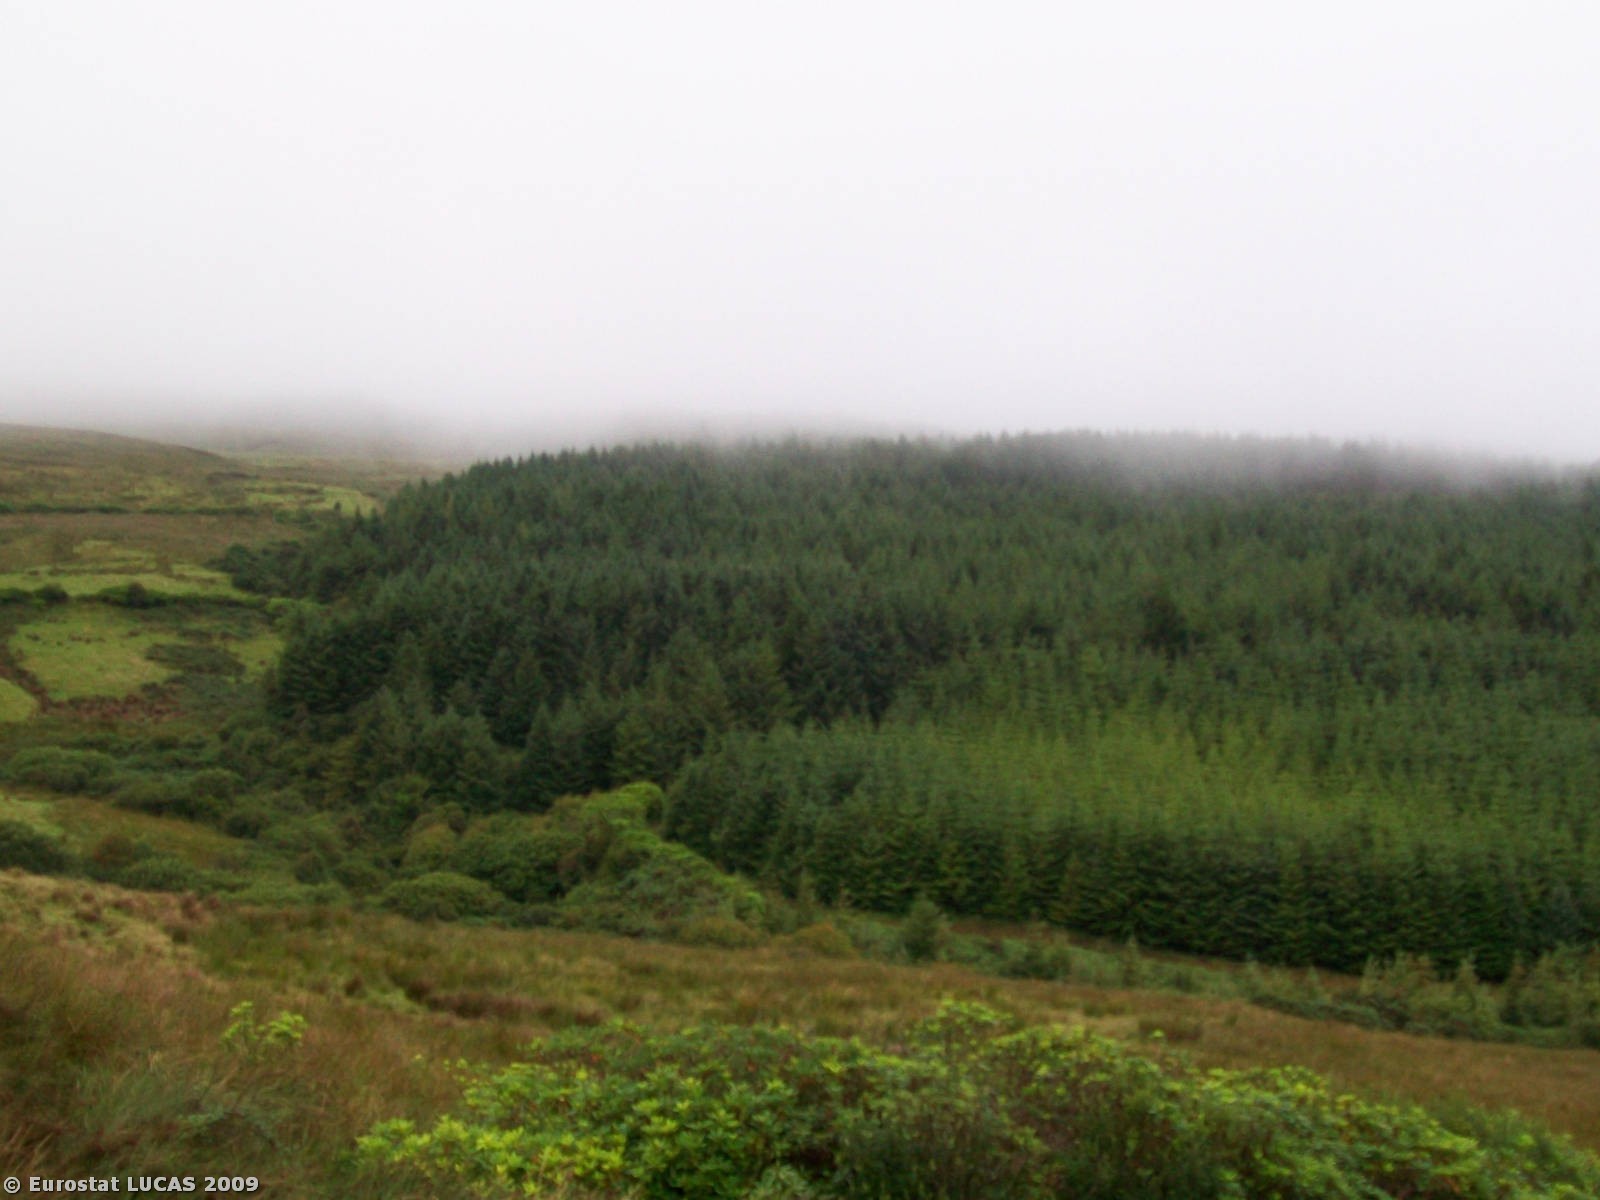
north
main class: Grassland
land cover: Grassland with sparse tree/shrub cover
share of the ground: > 75 %
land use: Agriculture (excluding fallow land and kitchen gardens)
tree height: < 5 m
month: August
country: IE
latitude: 52.8322
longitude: -9.2672
